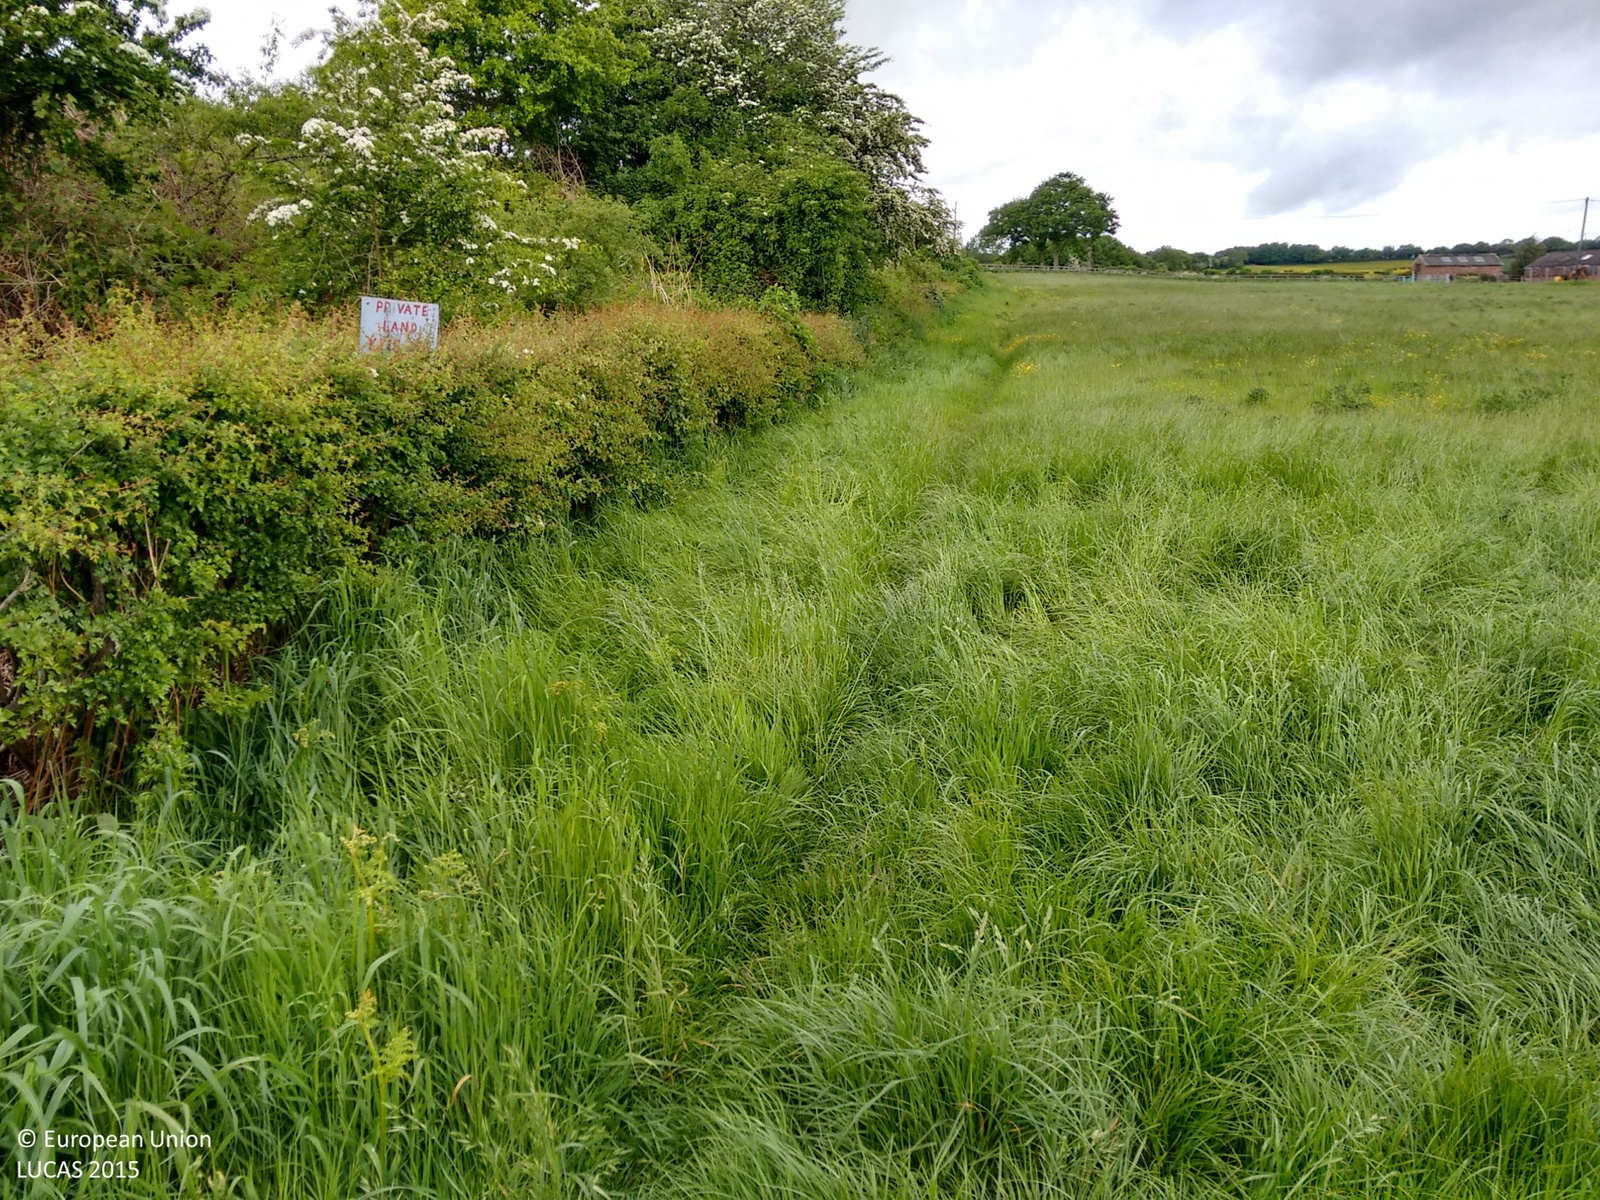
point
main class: Grassland
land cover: Grassland without tree/shrub cover
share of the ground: > 75 %
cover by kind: herbaceous plants 100 %
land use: Agriculture (excluding fallow land and kitchen gardens)
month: June
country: GB
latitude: 52.5395
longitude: -1.5370
